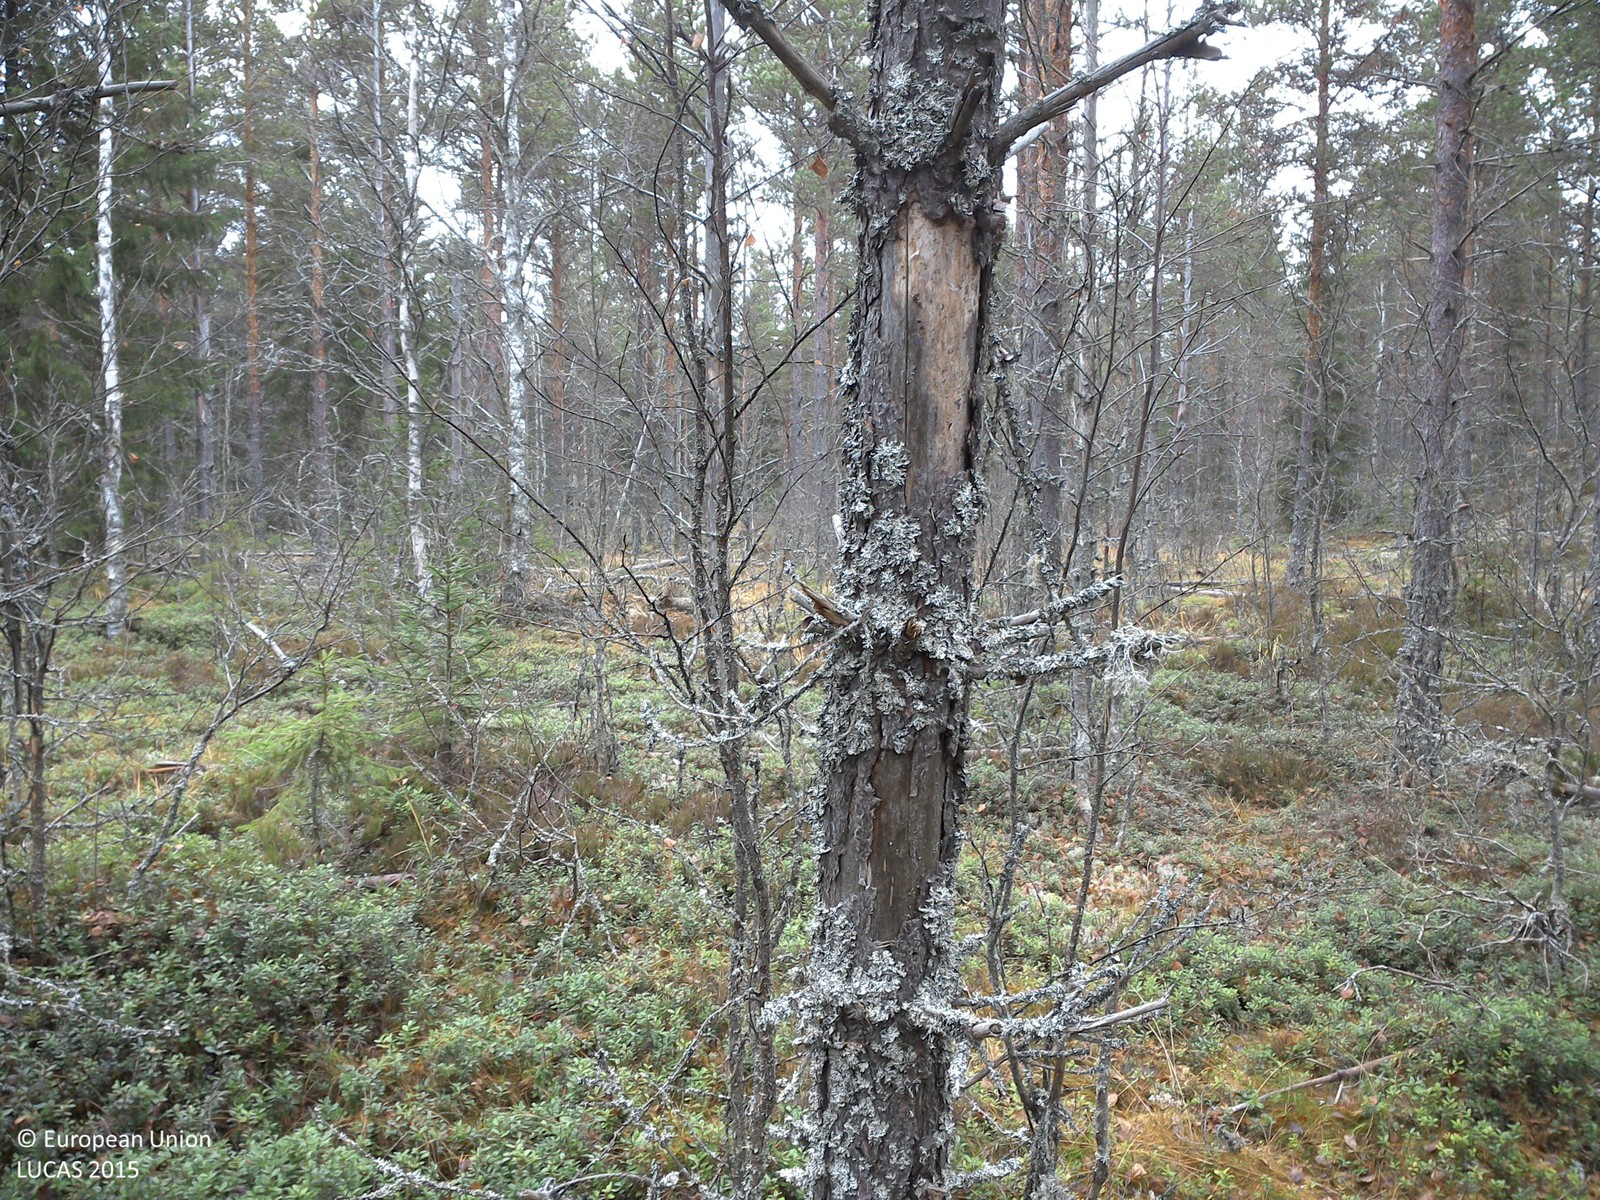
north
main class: Woodland
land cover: Pine dominated coniferous woodland
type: boreal forest
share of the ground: > 75 %
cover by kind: coniferous forest trees 65 %, shrubs 20 %, broadleaved forest trees 15 %
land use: Forestry
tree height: > 5 m
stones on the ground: < 10 %
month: November
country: SE
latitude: 60.1726
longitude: 14.1890
